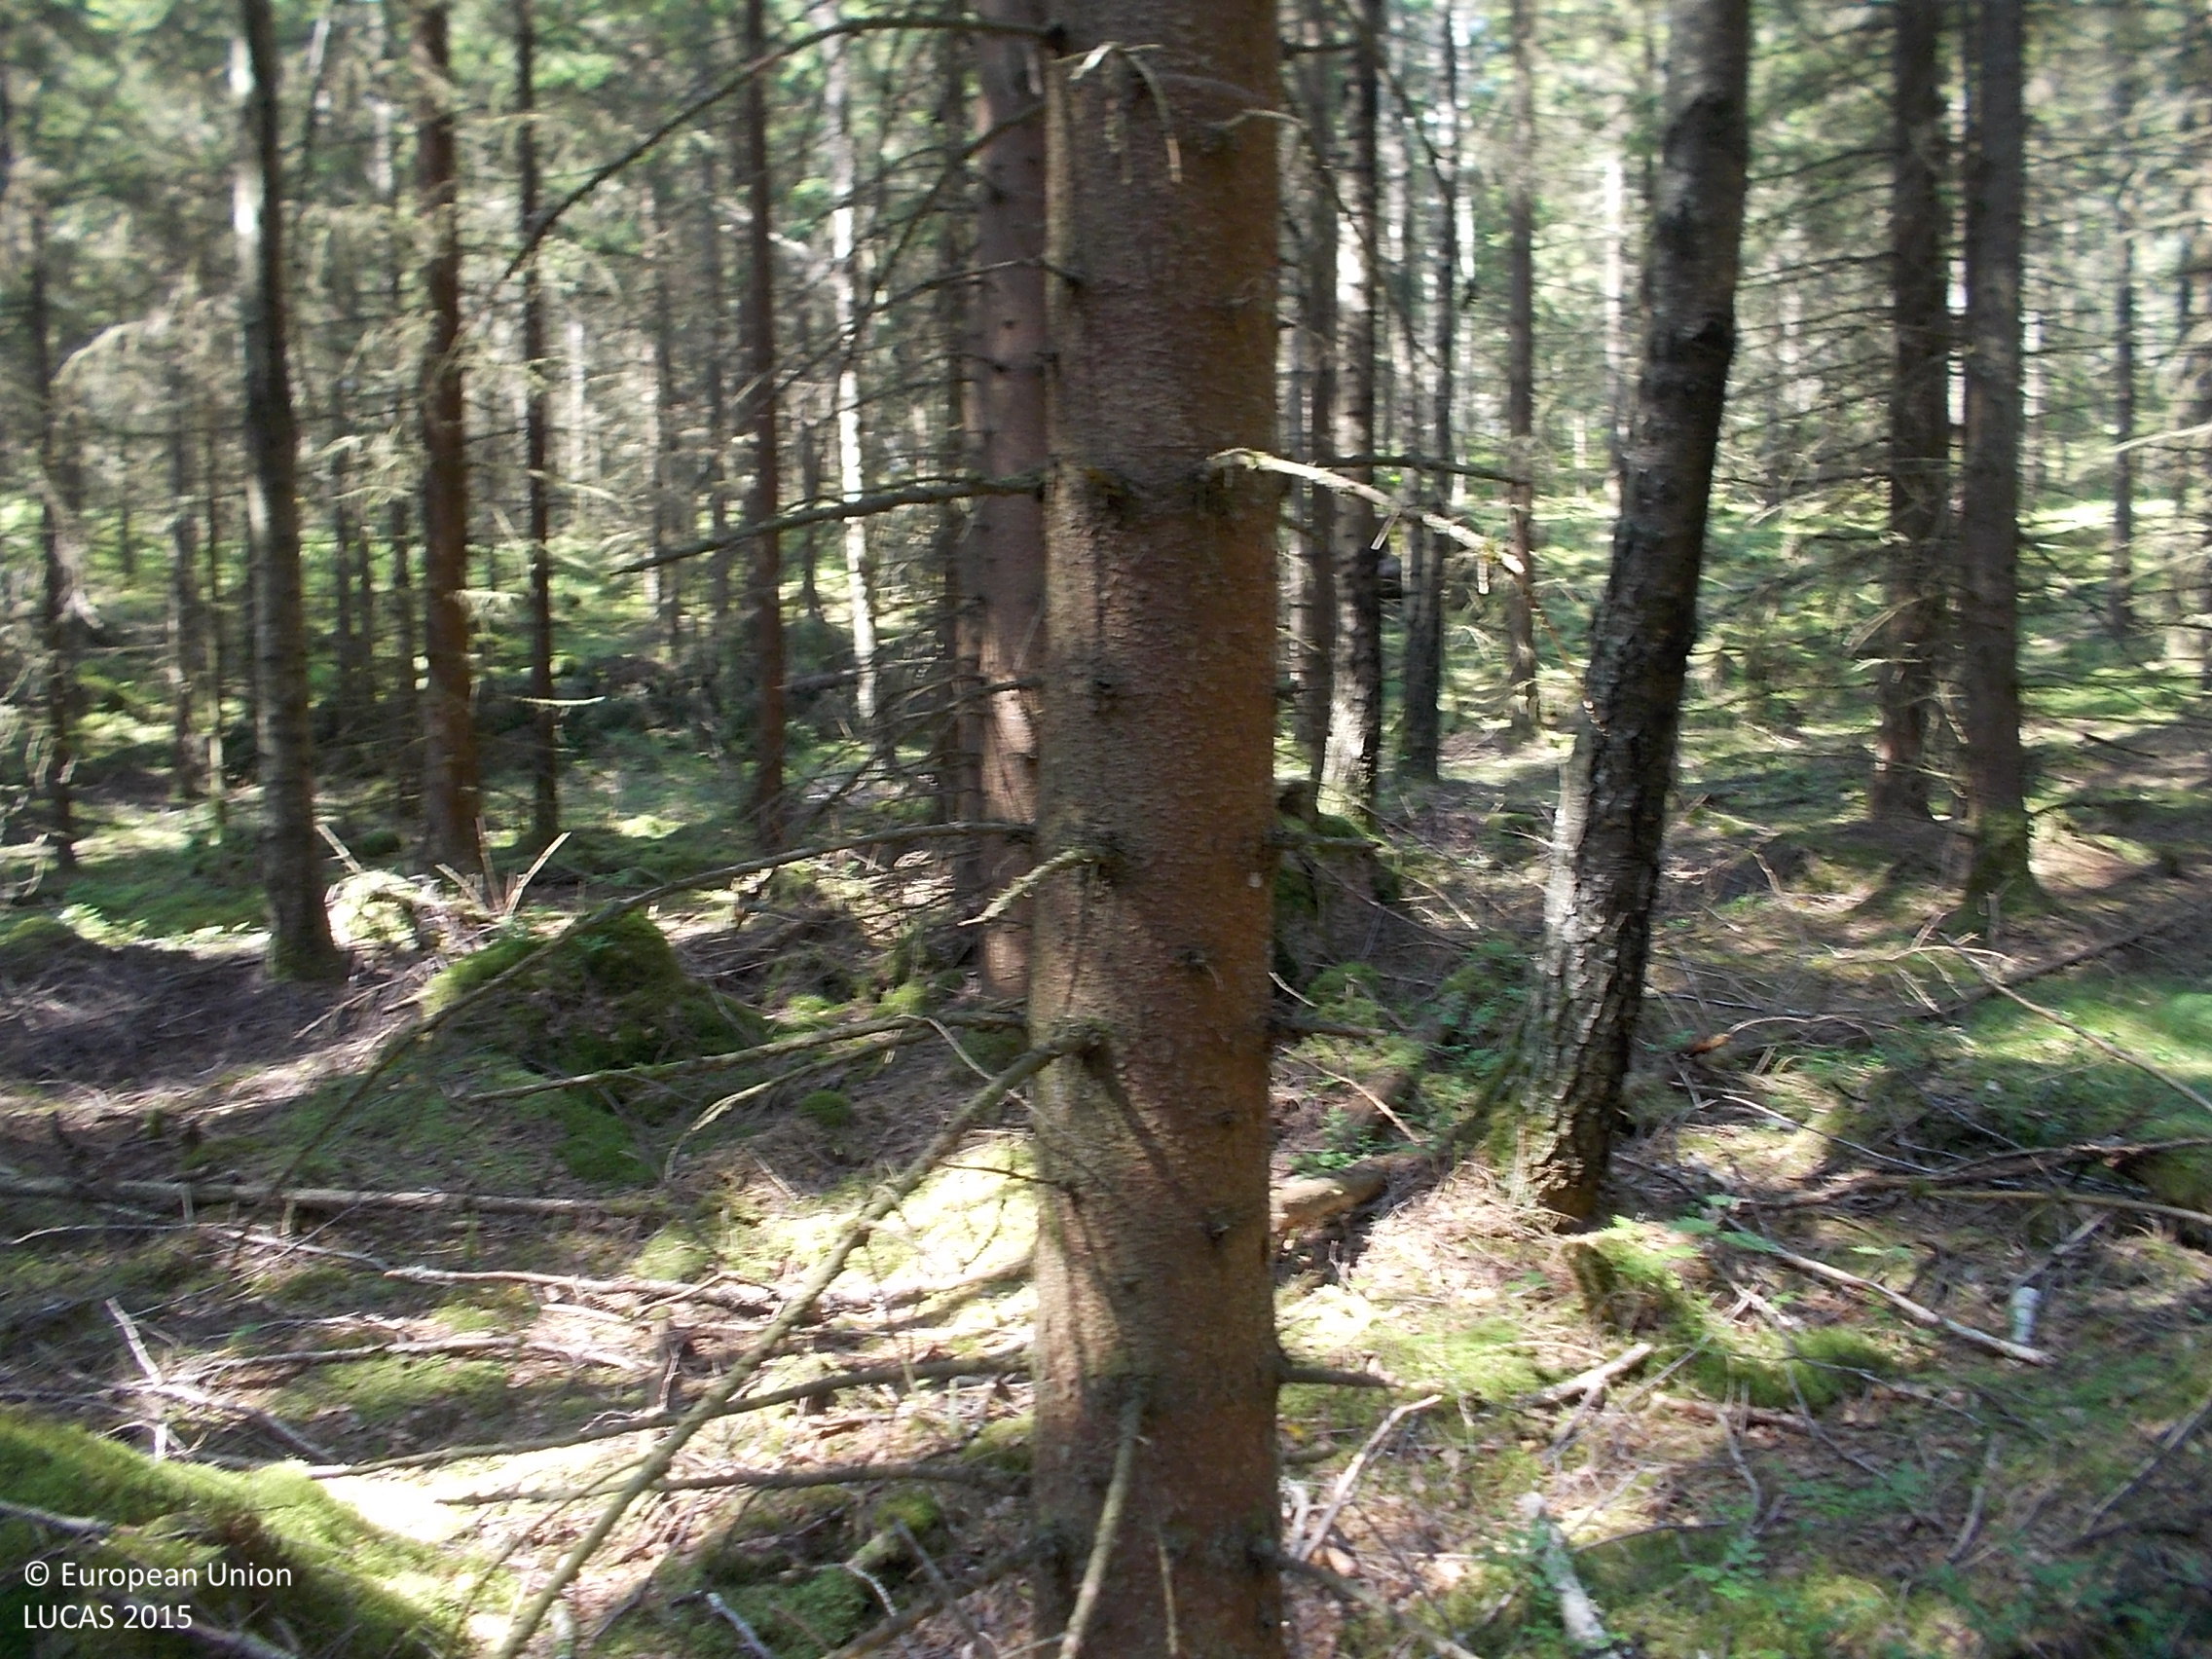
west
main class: Woodland
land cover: Spruce dominated coniferous woodland
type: boreal forest
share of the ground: > 75 %
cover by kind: coniferous forest trees 80 %, shrubs 10 %, lichens and mosses 10 %
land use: Forestry
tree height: > 5 m
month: August
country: SE
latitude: 57.5541
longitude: 13.0874
